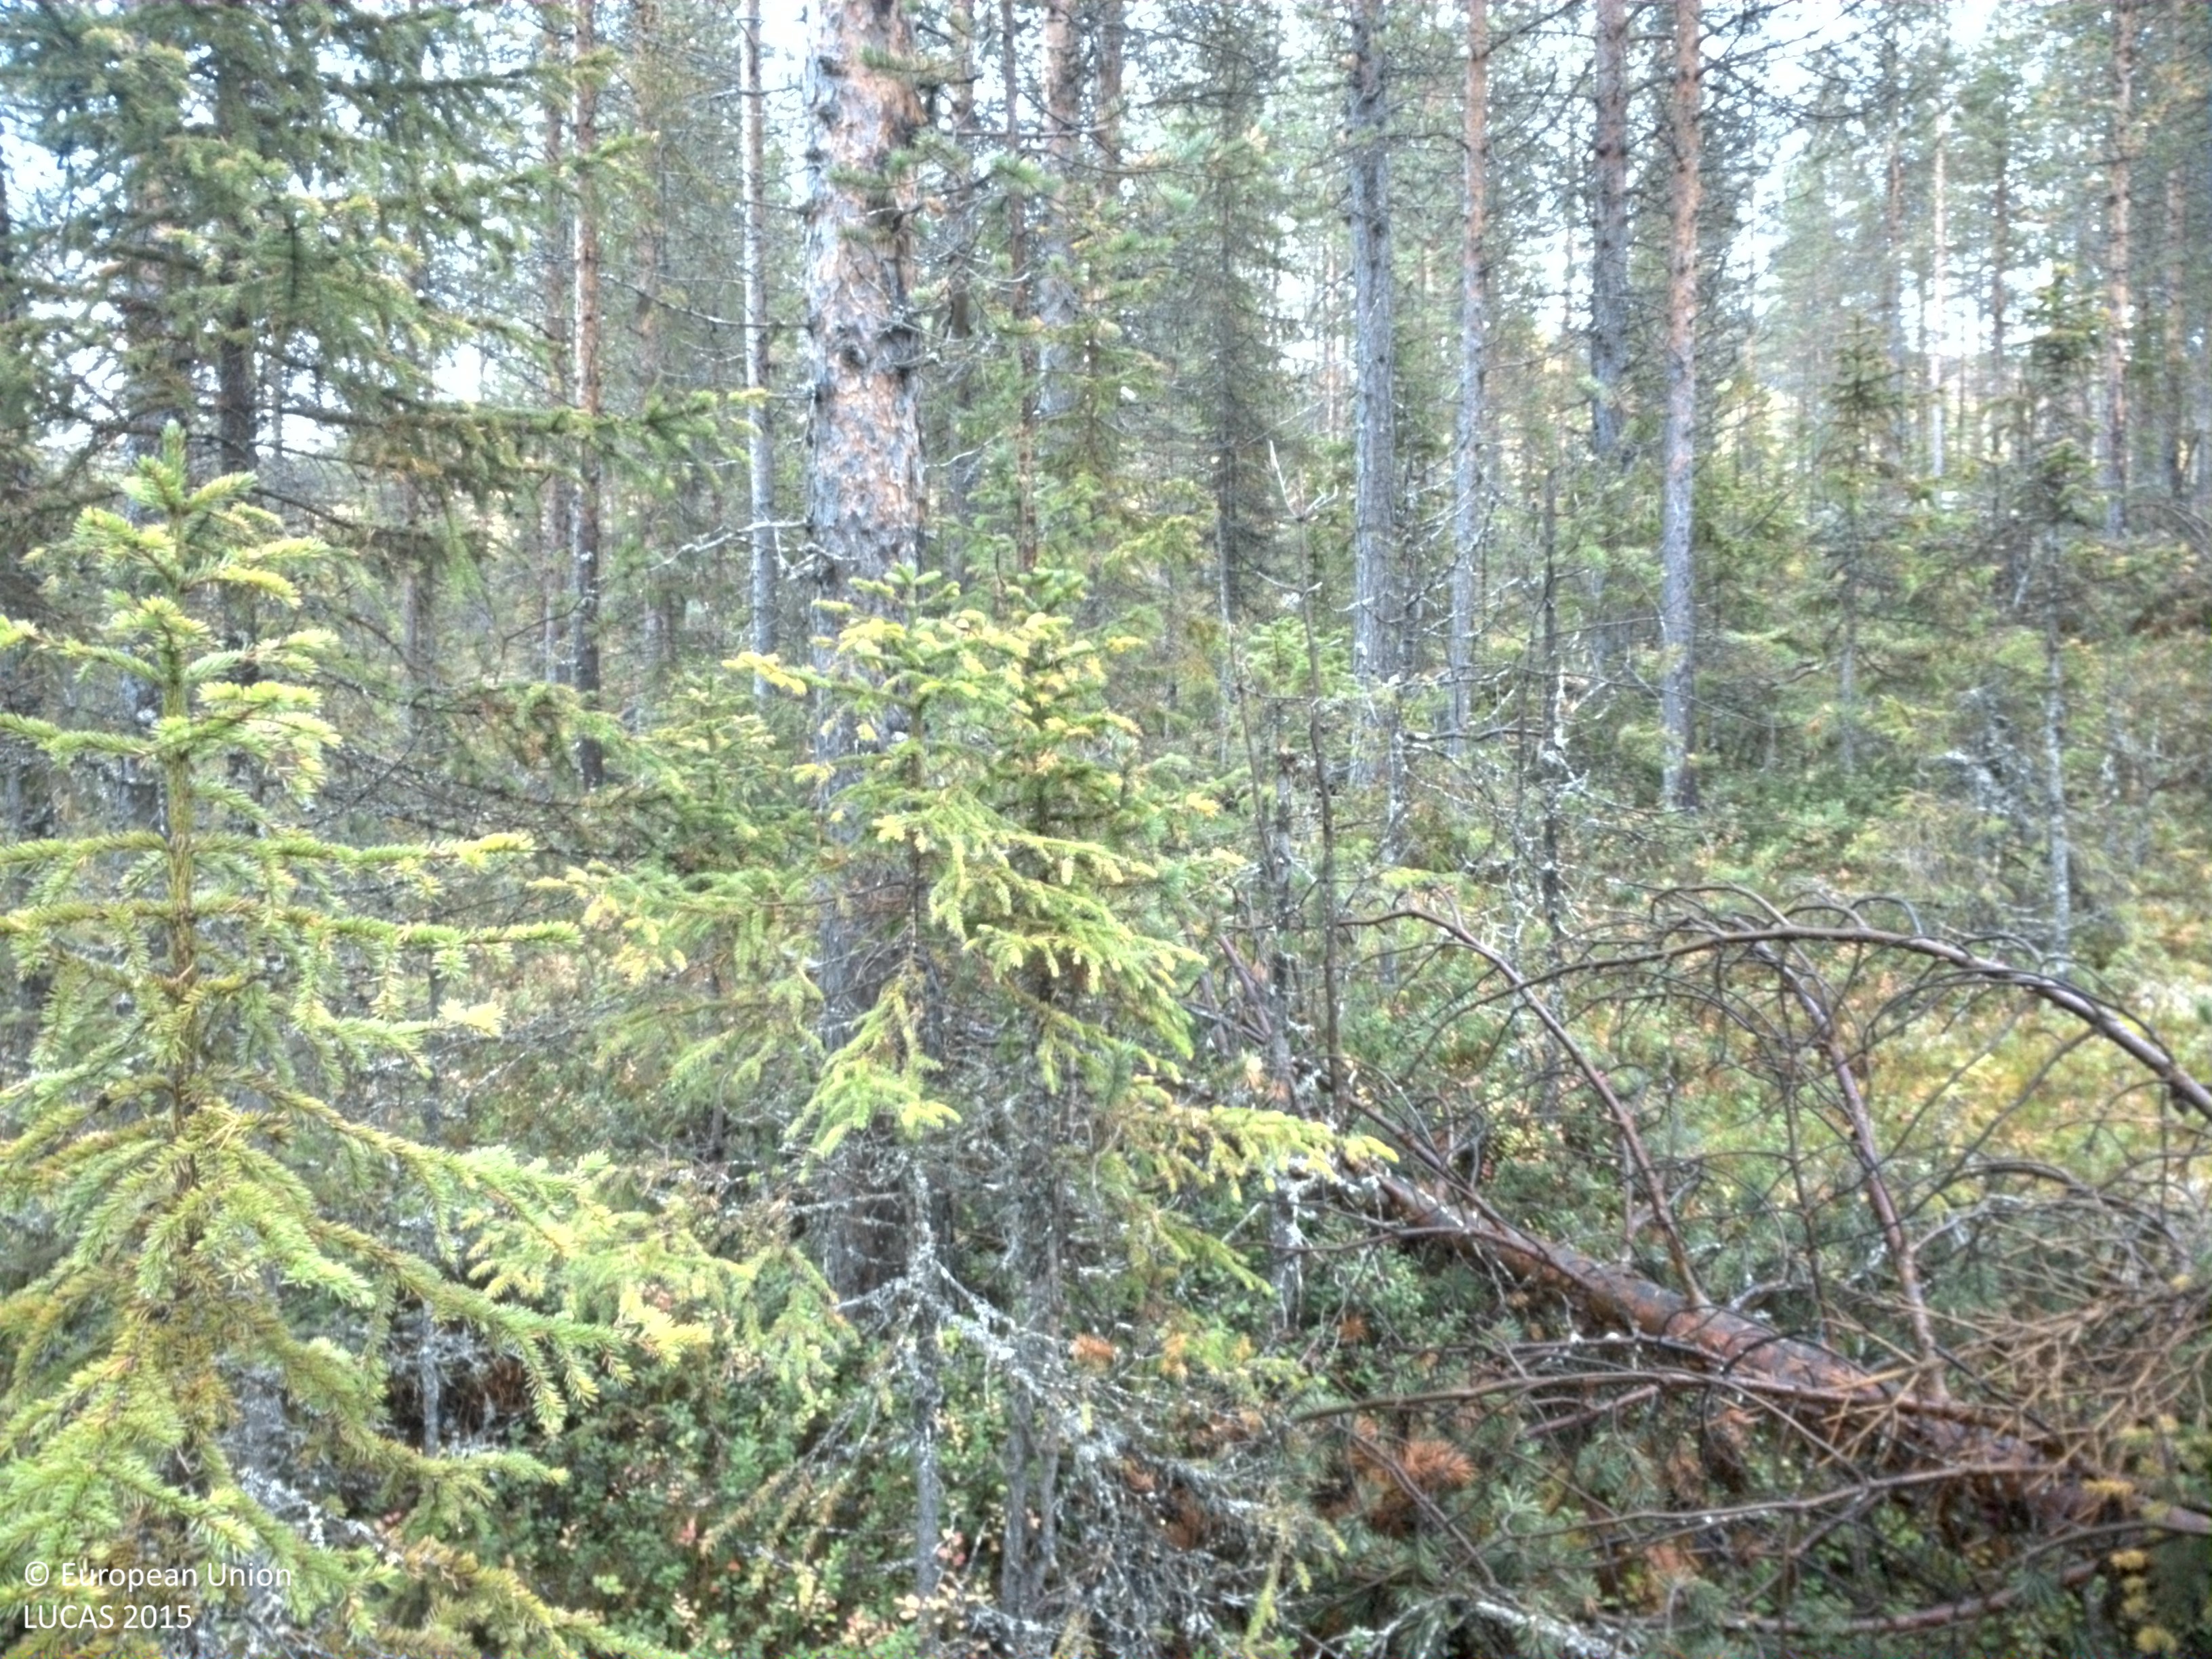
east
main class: Woodland
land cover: Other coniferous woodland
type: boreal forest
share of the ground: 25 - 50 %
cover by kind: coniferous forest trees 45 %, herbaceous plants 35 %, lichens and mosses 20 %
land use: Forestry
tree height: > 5 m
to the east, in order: Other coniferous woodland; Pine dominated coniferous woodland; Pine dominated mixed woodland; Spruce dominated mixed woodland; Groves; Paved roads, cycling and walking lanes; Abandoned hedges; Ditches and canals; Other mixed woodland; Pine dominated coniferous woodland; Shrubland with sparse tree cover
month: September
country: SE
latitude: 65.0876
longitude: 17.6011
